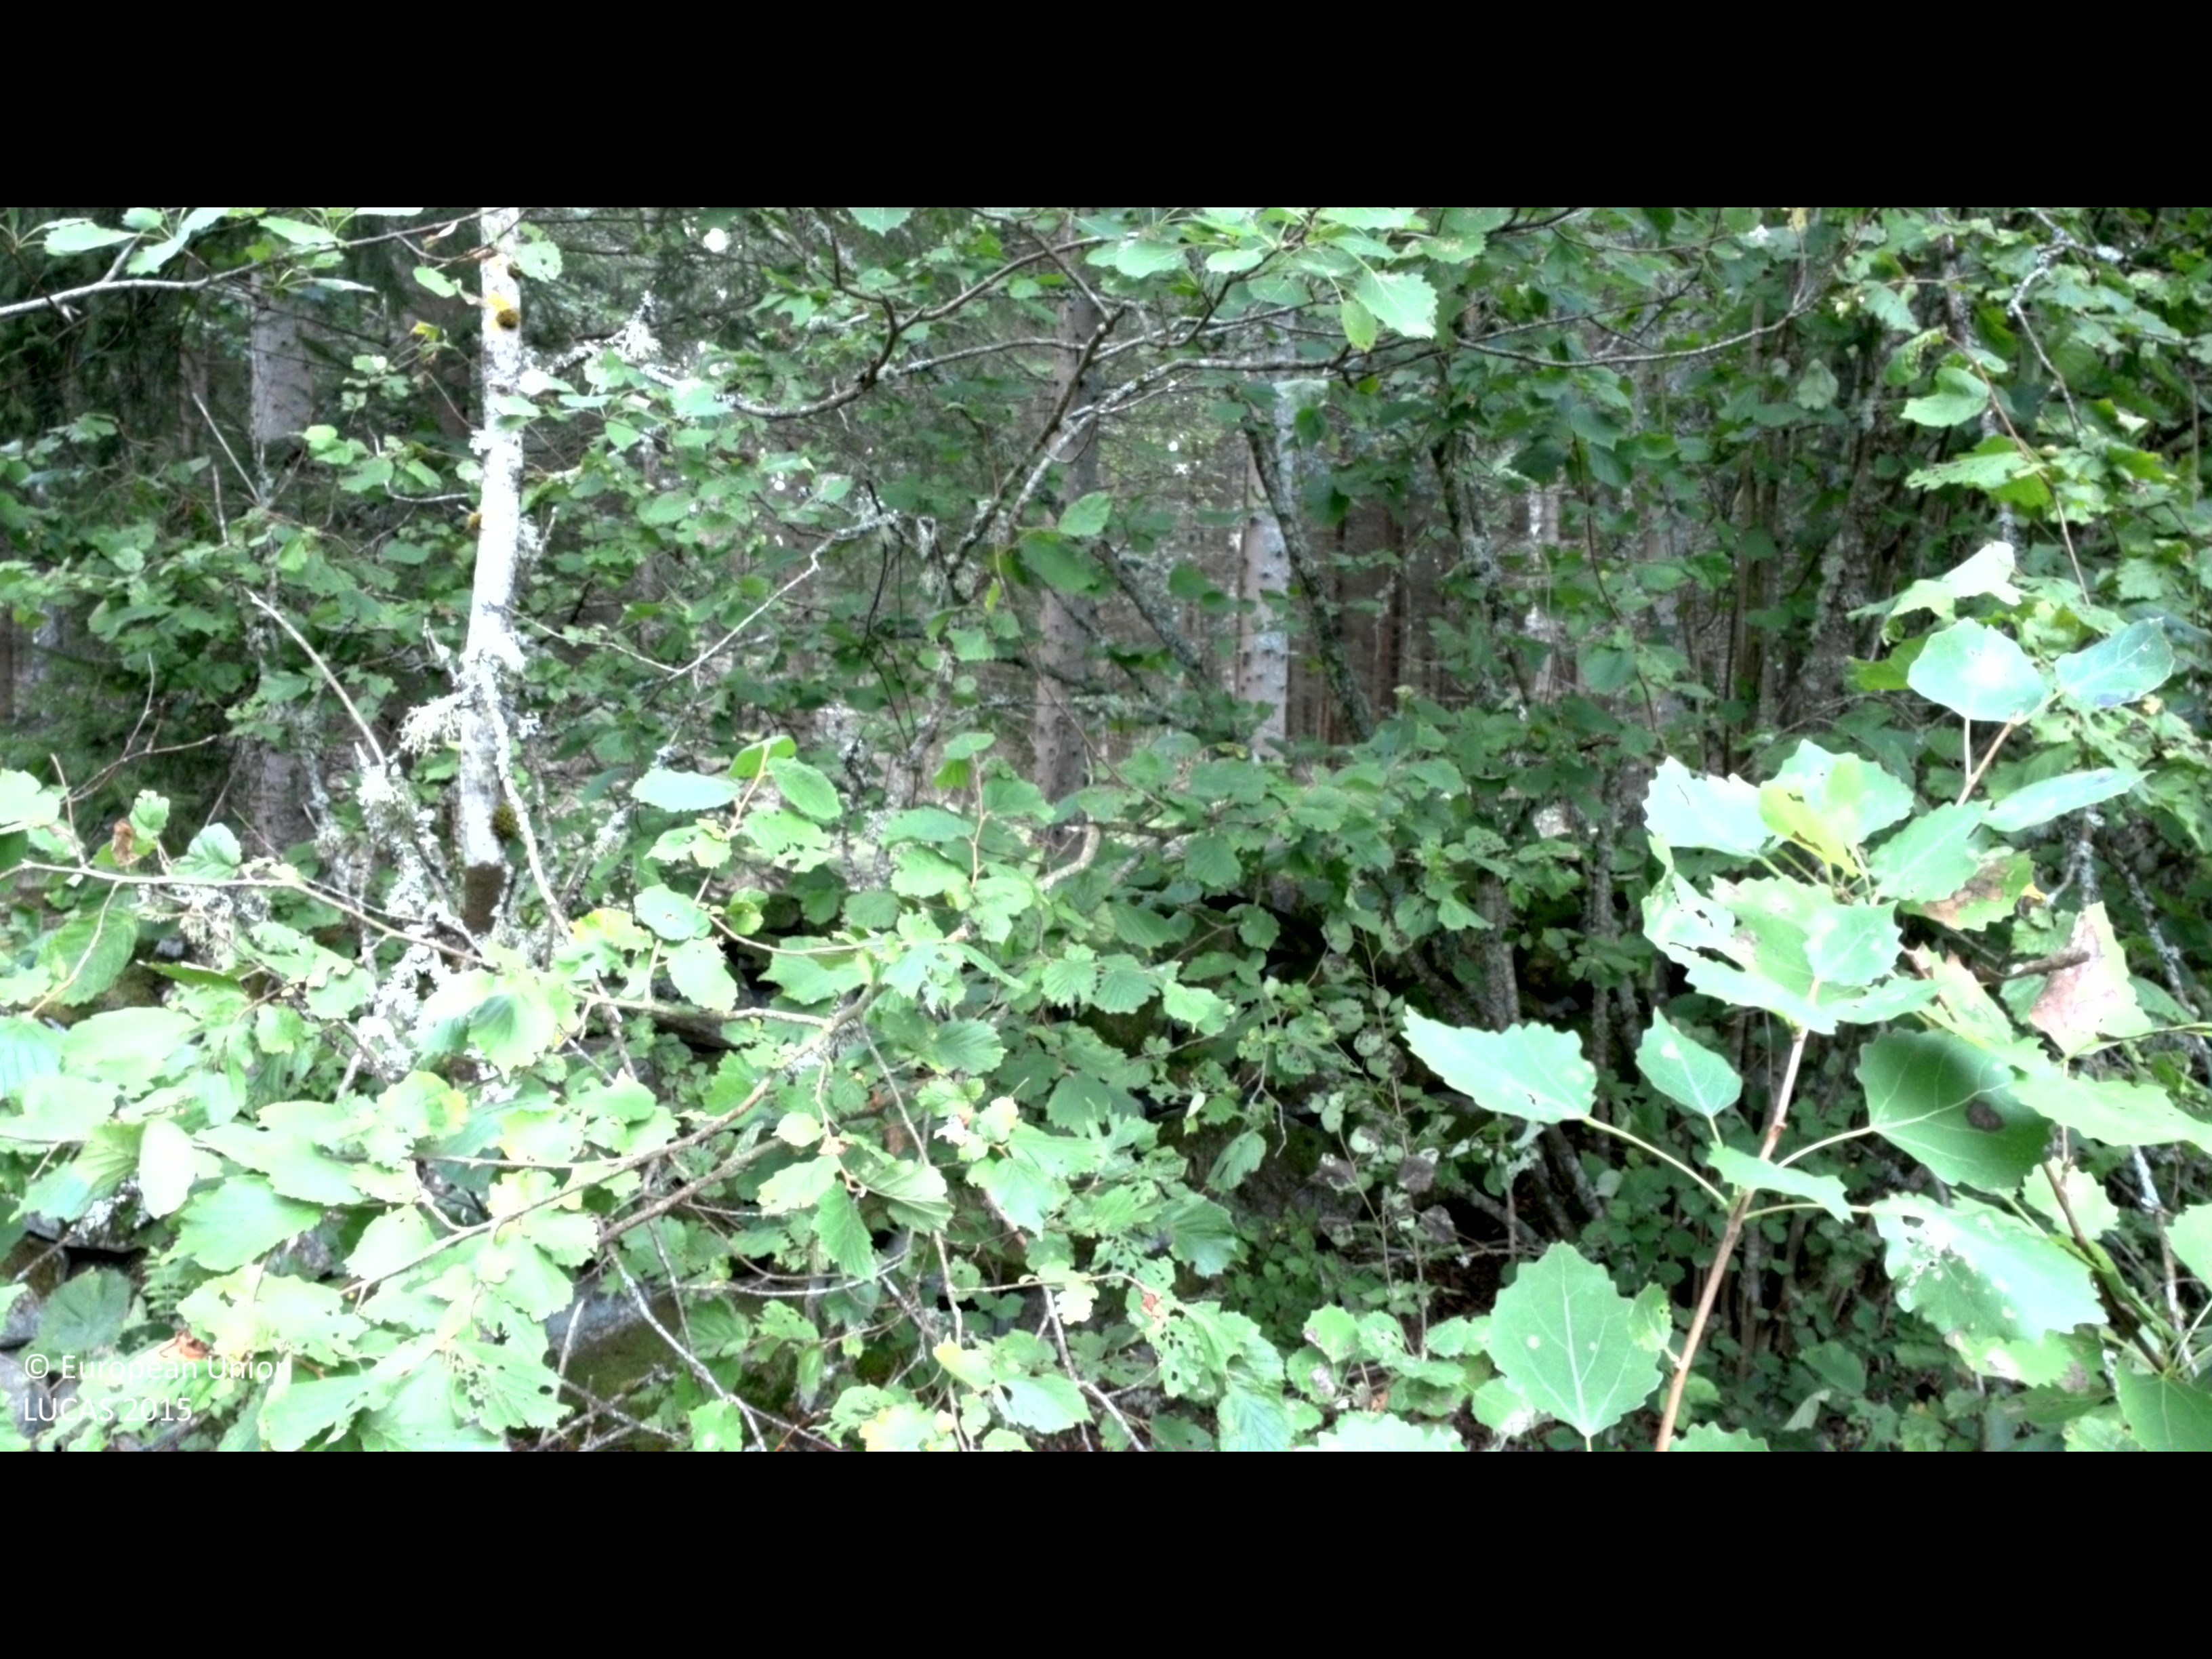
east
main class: Woodland
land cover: Broadleaved woodland
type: hemiboreal forest and nemoral coniferous forest and mixed broadleaved-coniferous forest
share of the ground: 25 - 50 %
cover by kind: broadleaved forest trees 50 %, shrubs 25 %, herbaceous plants 25 %
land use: Forestry
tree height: > 5 m
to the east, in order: Broadleaved woodland; Dry stone walls; Spruce dominated mixed woodland; Spruce dominated coniferous woodland; Tracks; Pine dominated mixed woodland; Ditches and canals; Spruce dominated mixed woodland; Spruce dominated coniferous woodland
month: August
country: SE
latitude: 56.7683
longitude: 14.1689
